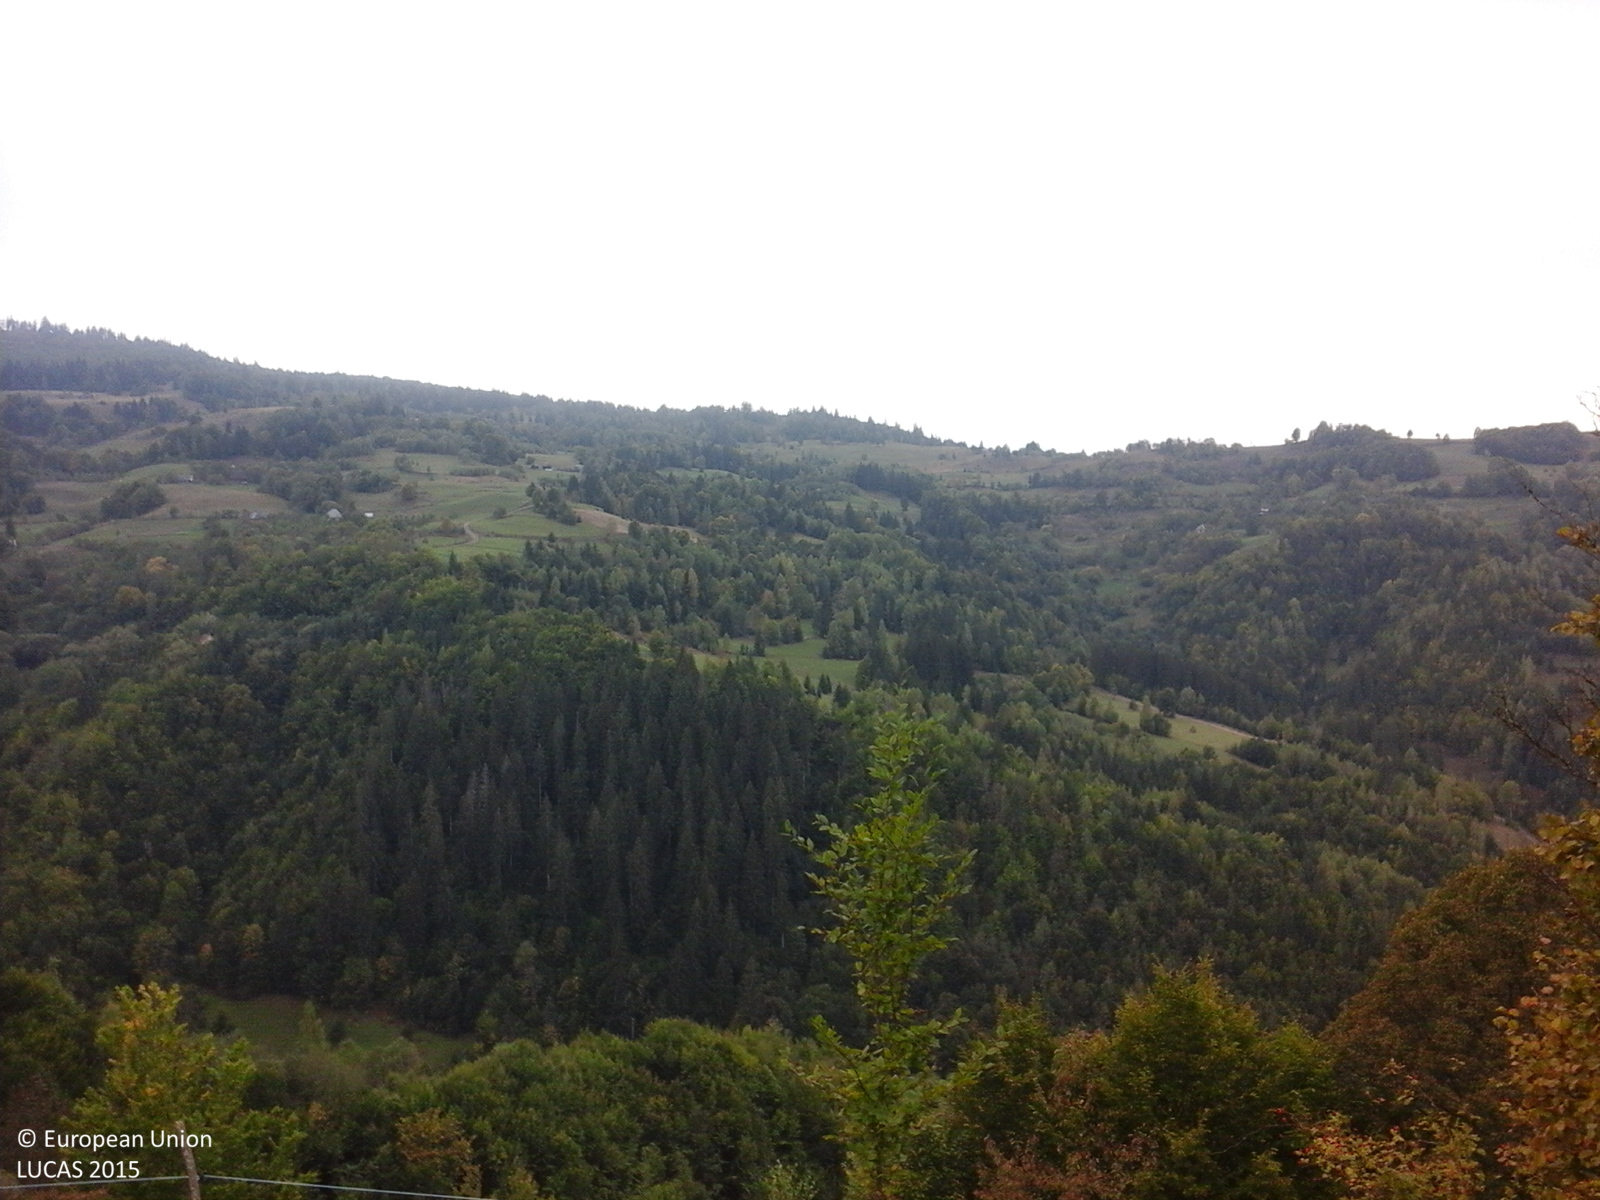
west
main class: Grassland
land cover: Grassland with sparse tree/shrub cover
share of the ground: > 75 %
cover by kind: herbaceous plants 85 %, shrubs 10 %, broadleaved forest trees 5 %
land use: Agriculture (excluding fallow land and kitchen gardens)
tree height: > 5 m
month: October
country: RO
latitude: 46.3593
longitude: 23.1222
